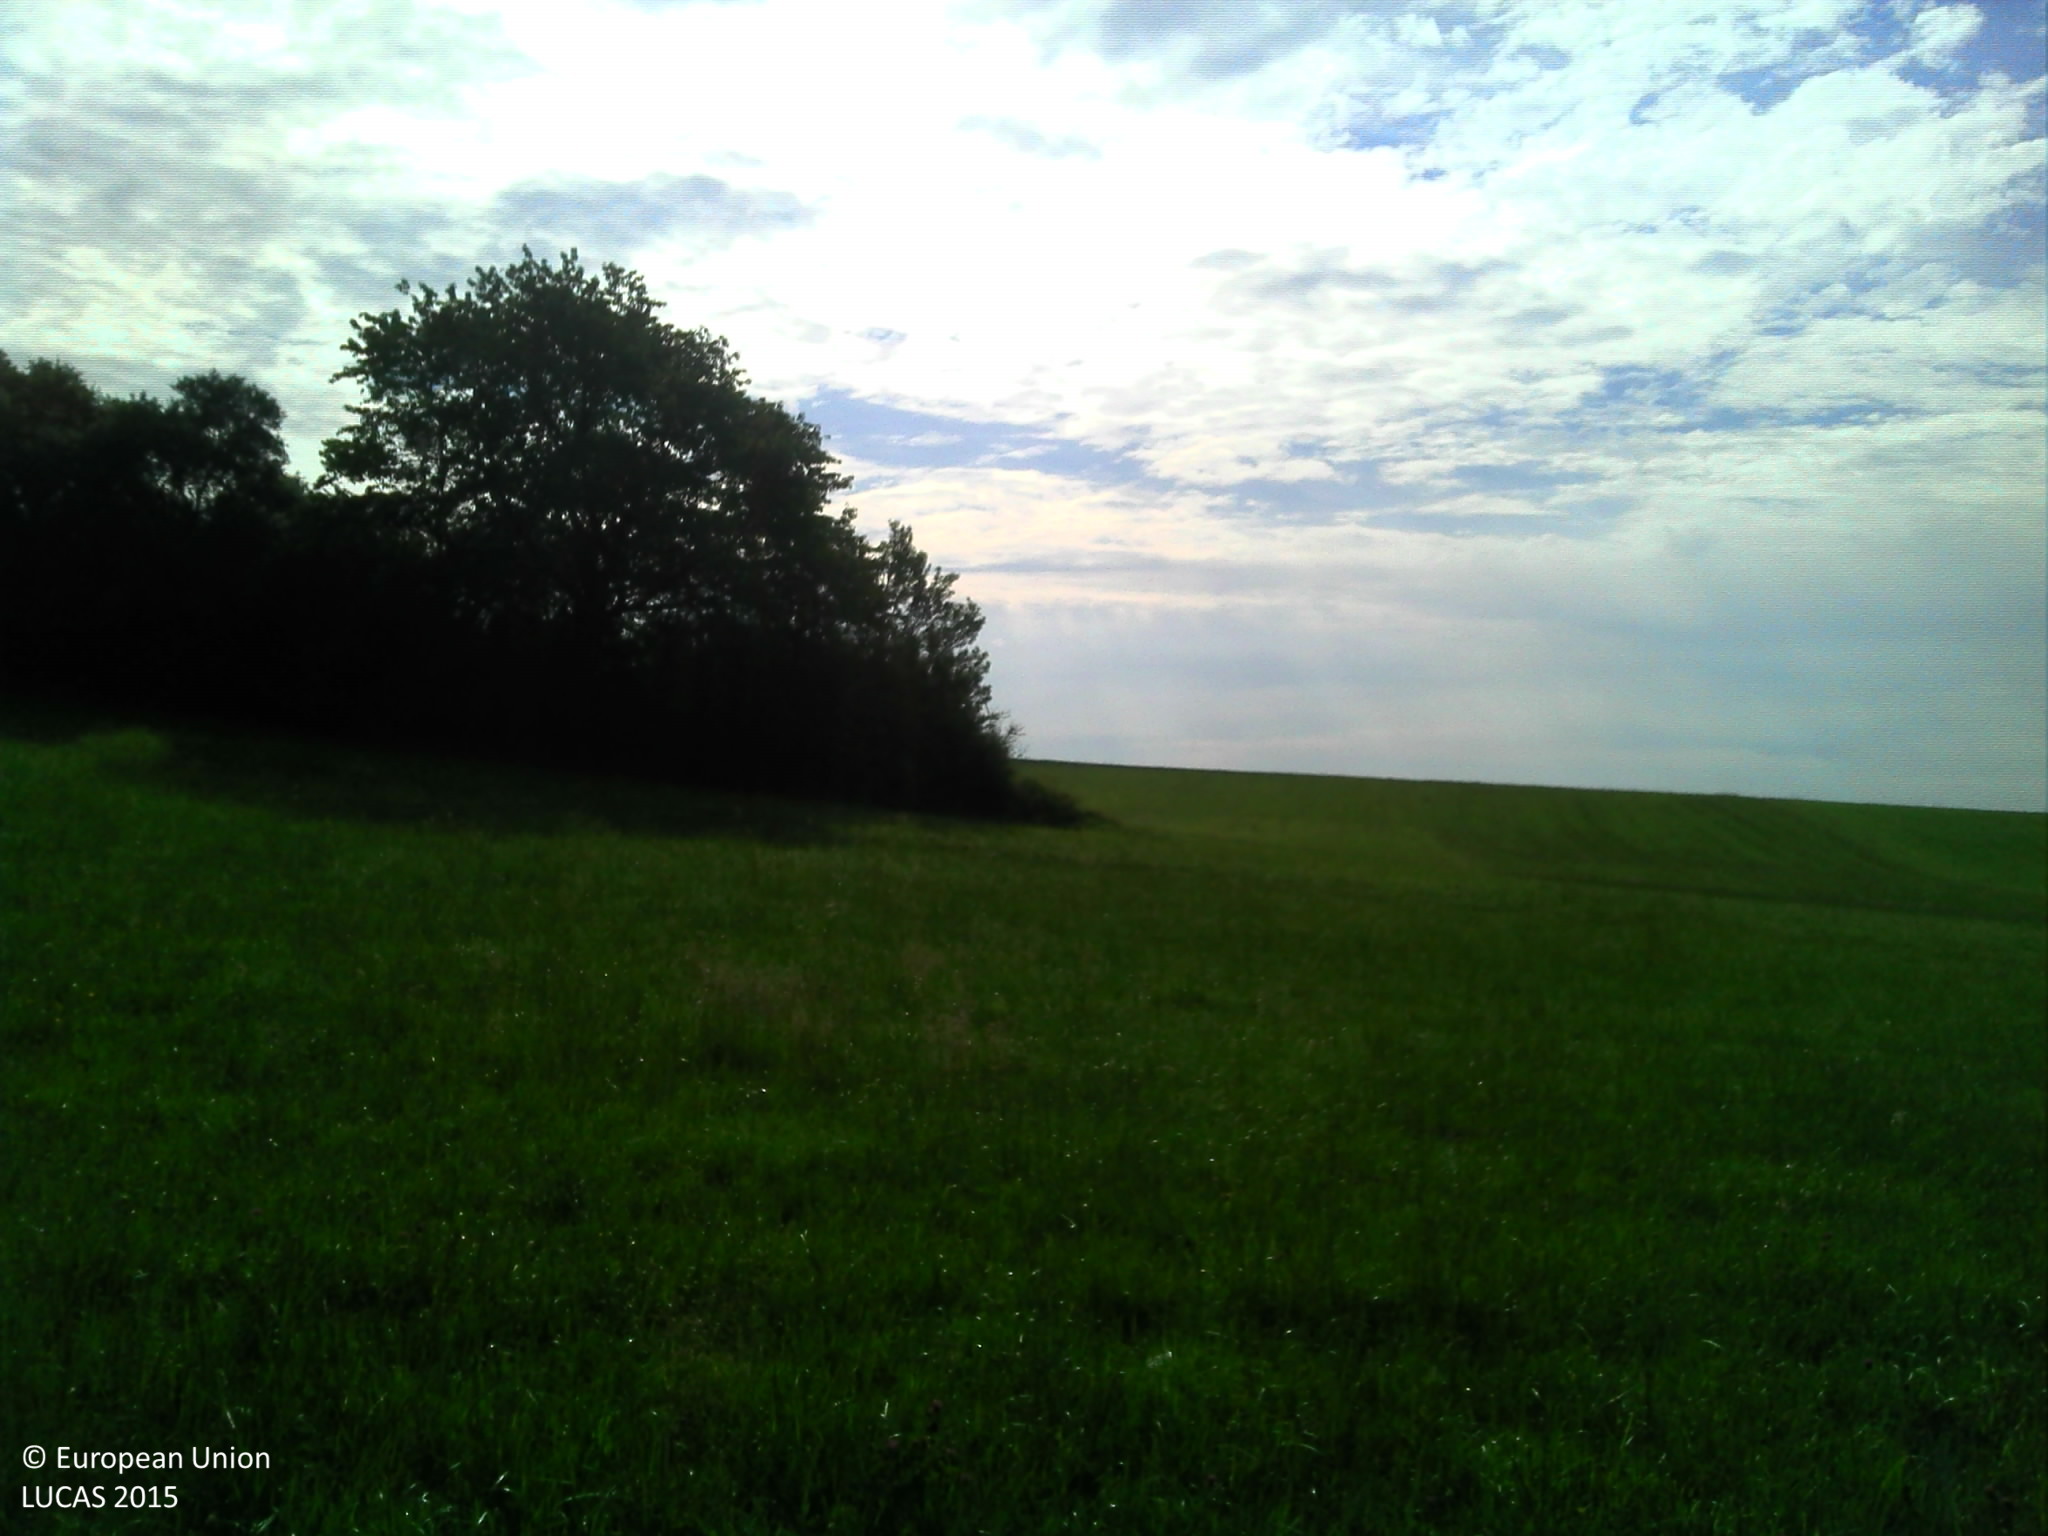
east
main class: Grassland
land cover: Grassland without tree/shrub cover
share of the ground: > 75 %
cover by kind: herbaceous plants 100 %
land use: Agriculture (excluding fallow land and kitchen gardens)
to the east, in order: Grassland without tree/shrub cover; Broadleaved woodland; Grassland without tree/shrub cover; Barley
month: June
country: LU
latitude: 49.7487
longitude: 6.3773
